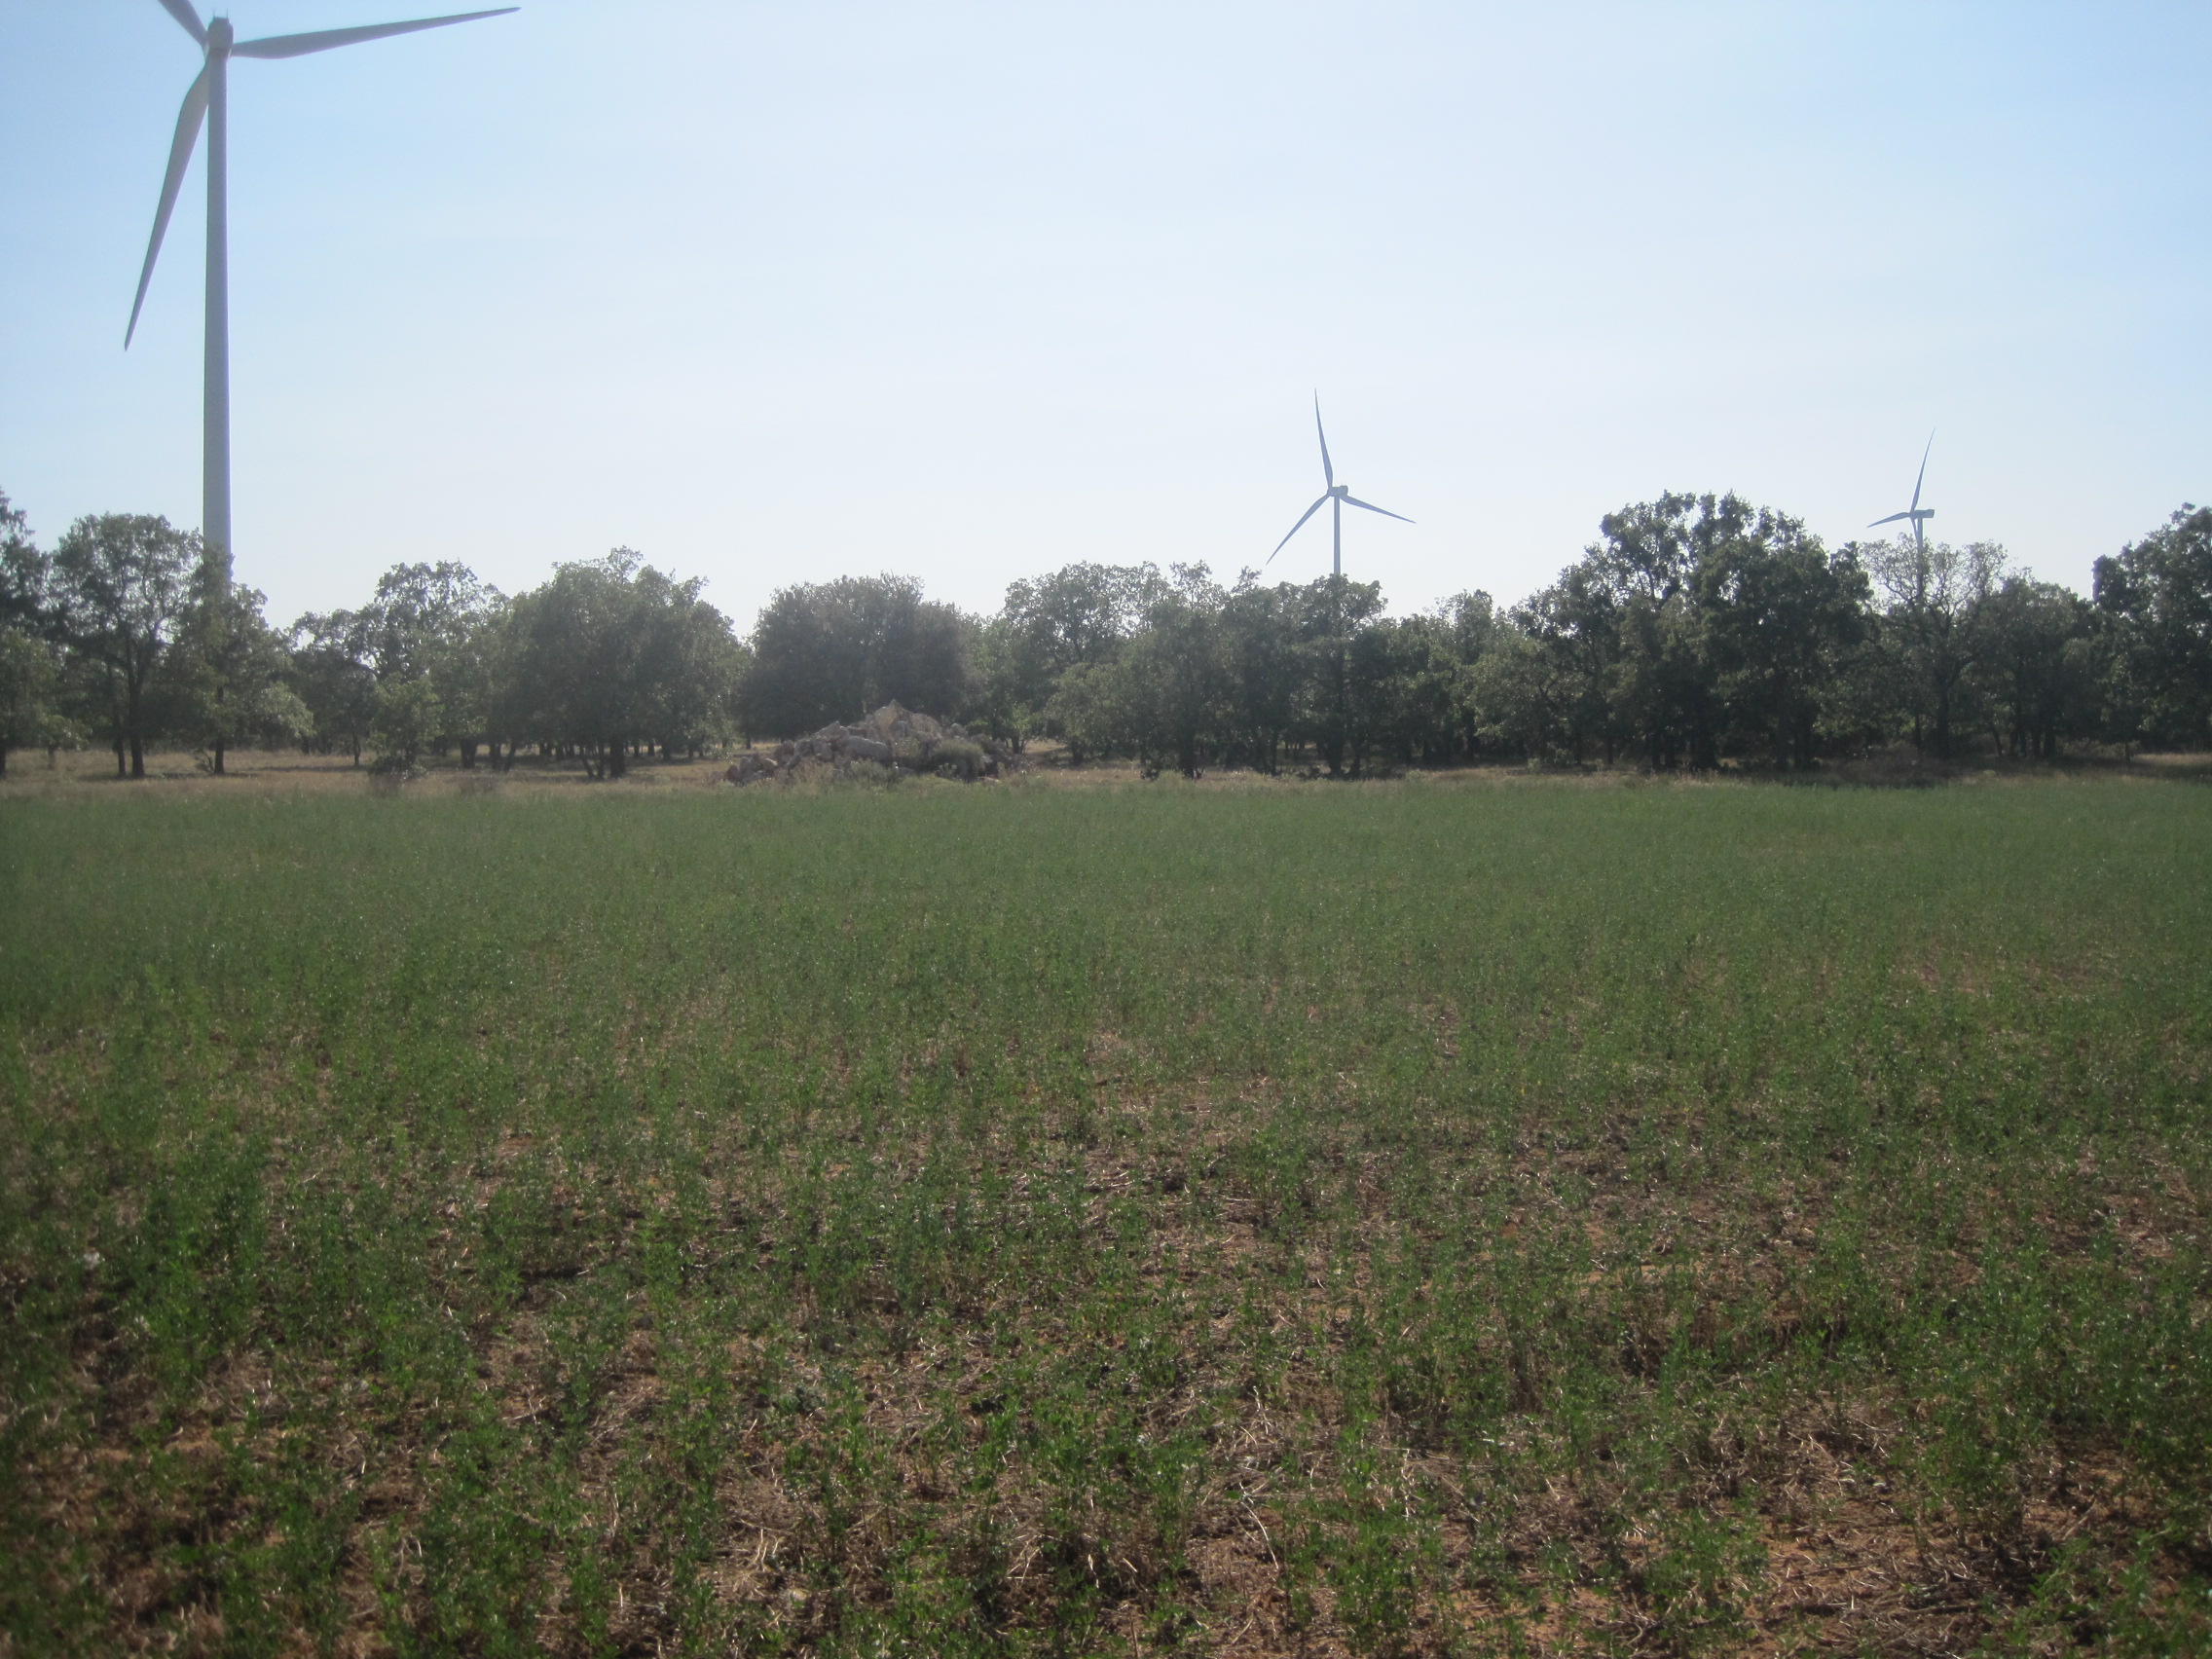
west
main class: Cropland
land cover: Lucerne
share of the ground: > 75 %
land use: Agriculture (excluding fallow land and kitchen gardens)
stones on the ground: 25 - 50 %
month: July
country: ES
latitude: 41.8773
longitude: -4.7611
